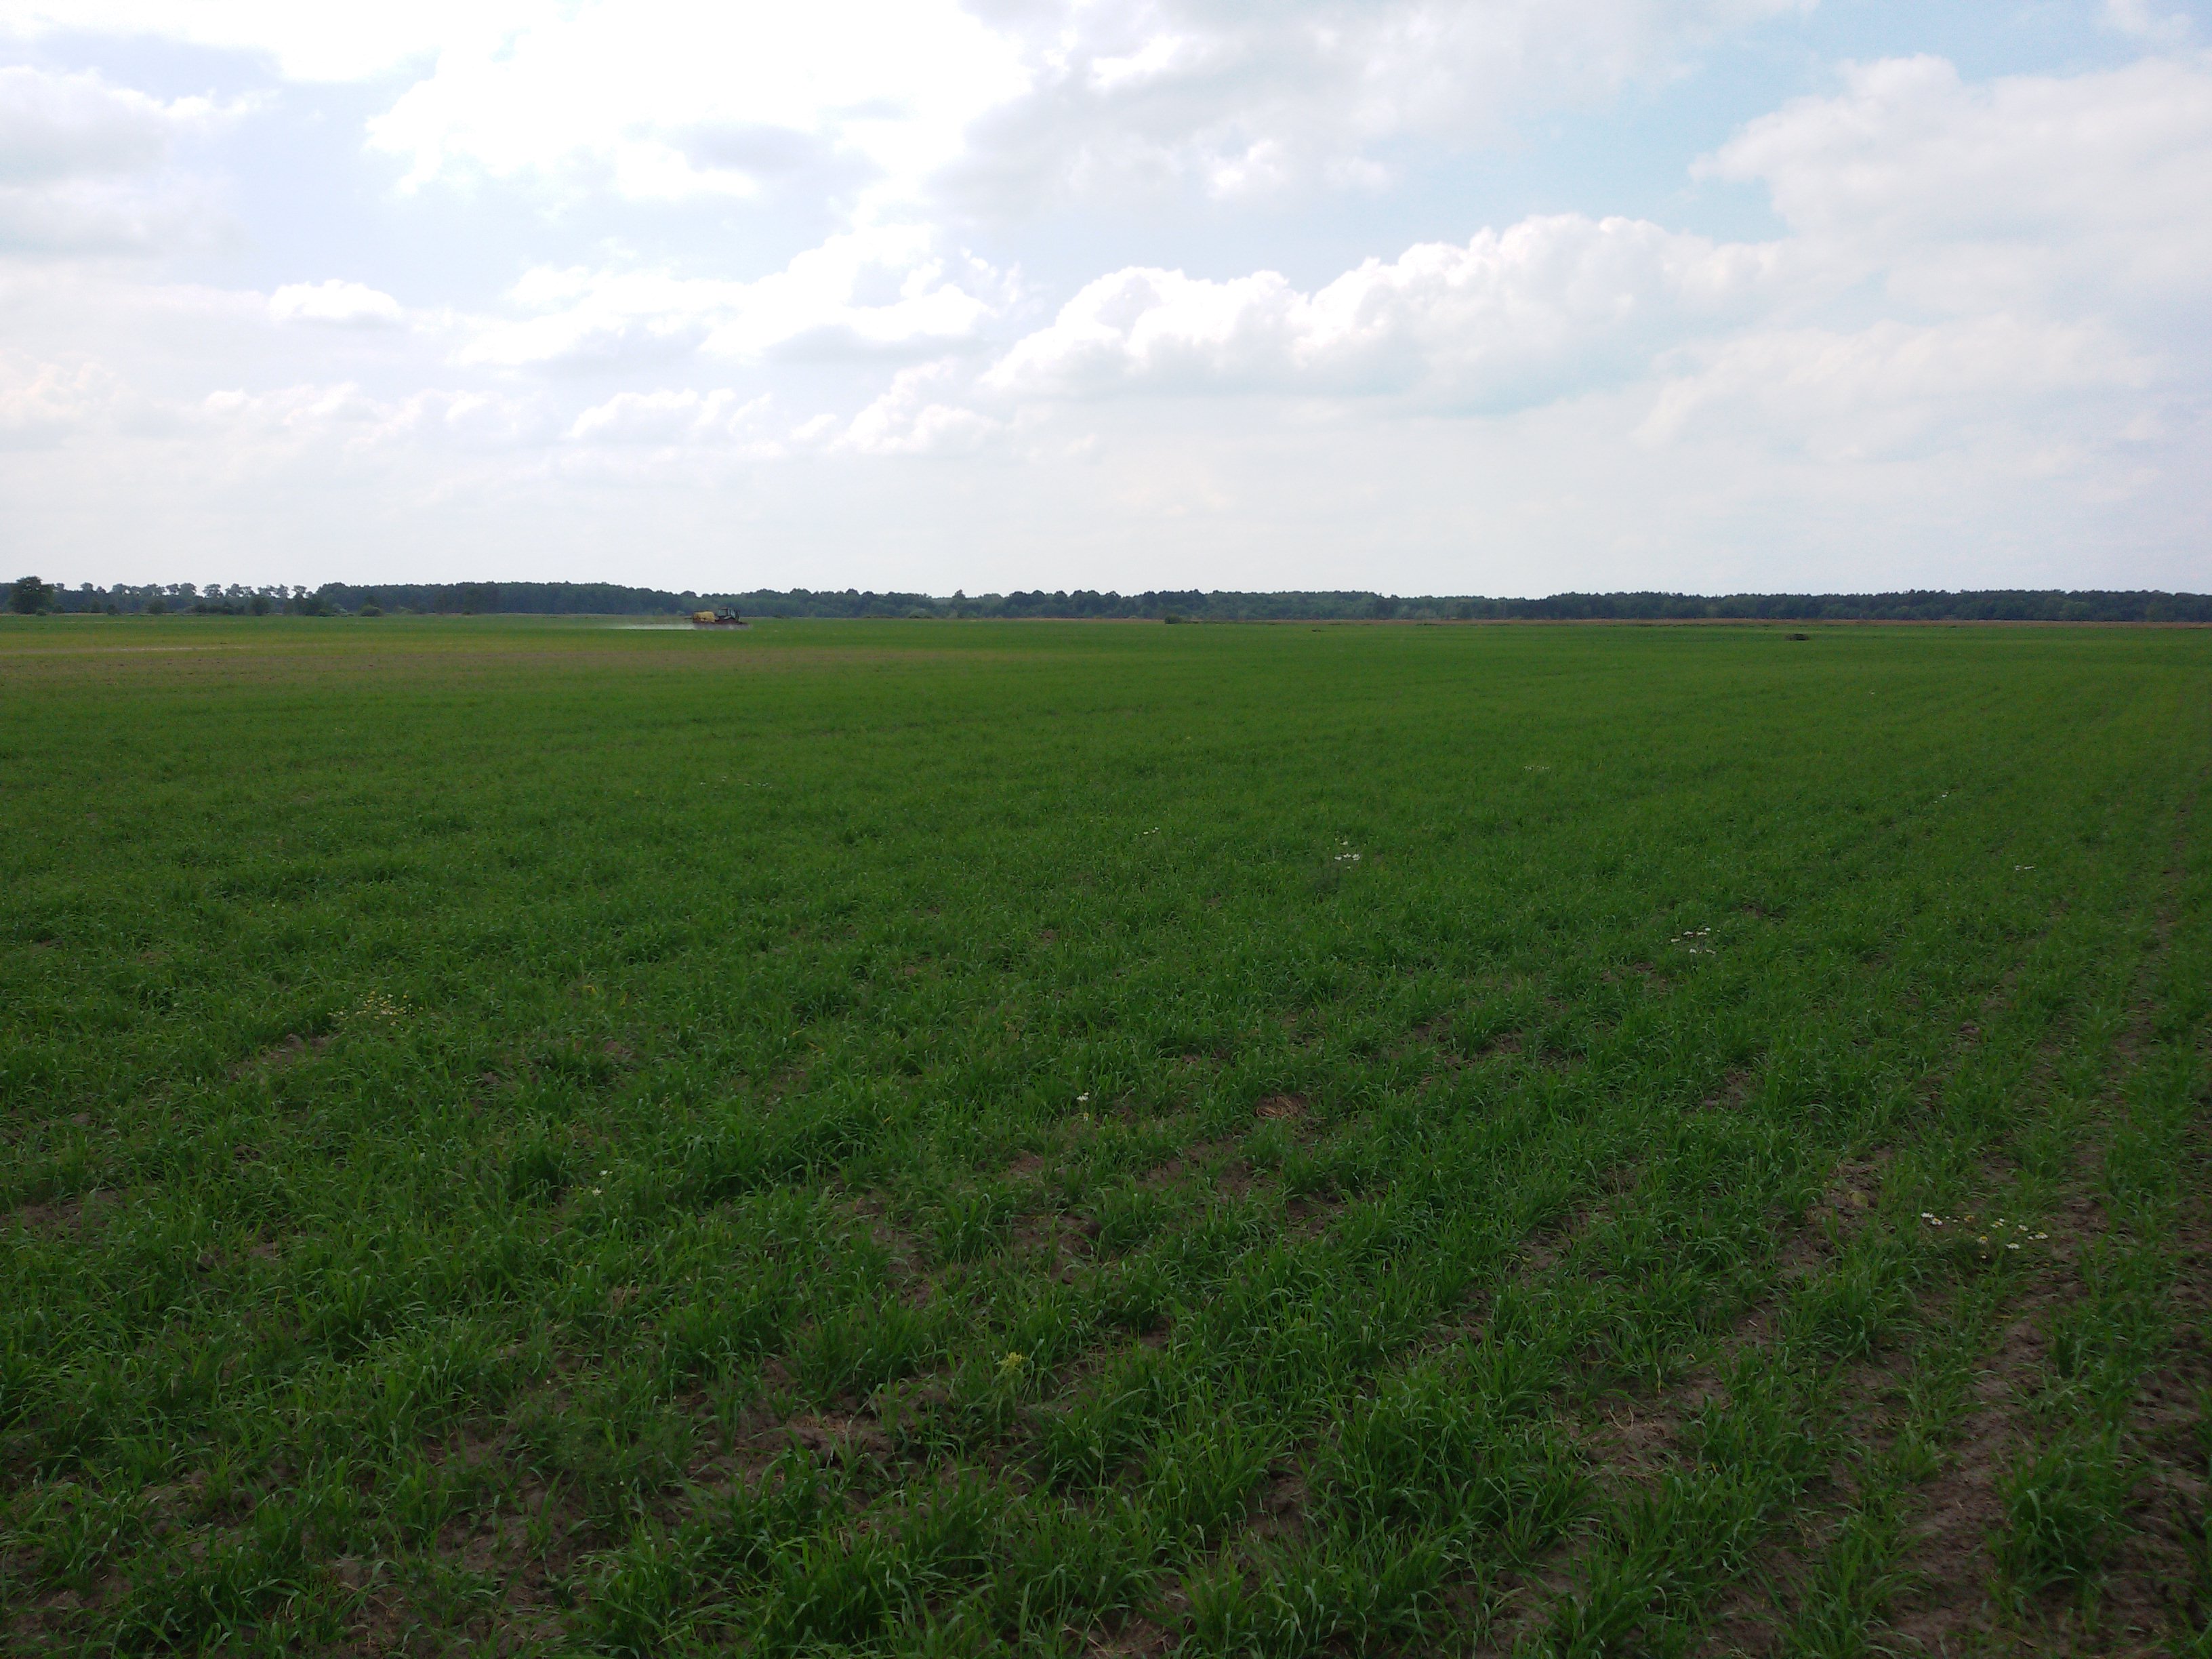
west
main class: Grassland
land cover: Grassland without tree/shrub cover
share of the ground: > 75 %
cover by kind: herbaceous plants 100 %
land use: Agriculture (excluding fallow land and kitchen gardens)
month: June
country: PL
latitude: 51.9862
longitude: 23.6439
